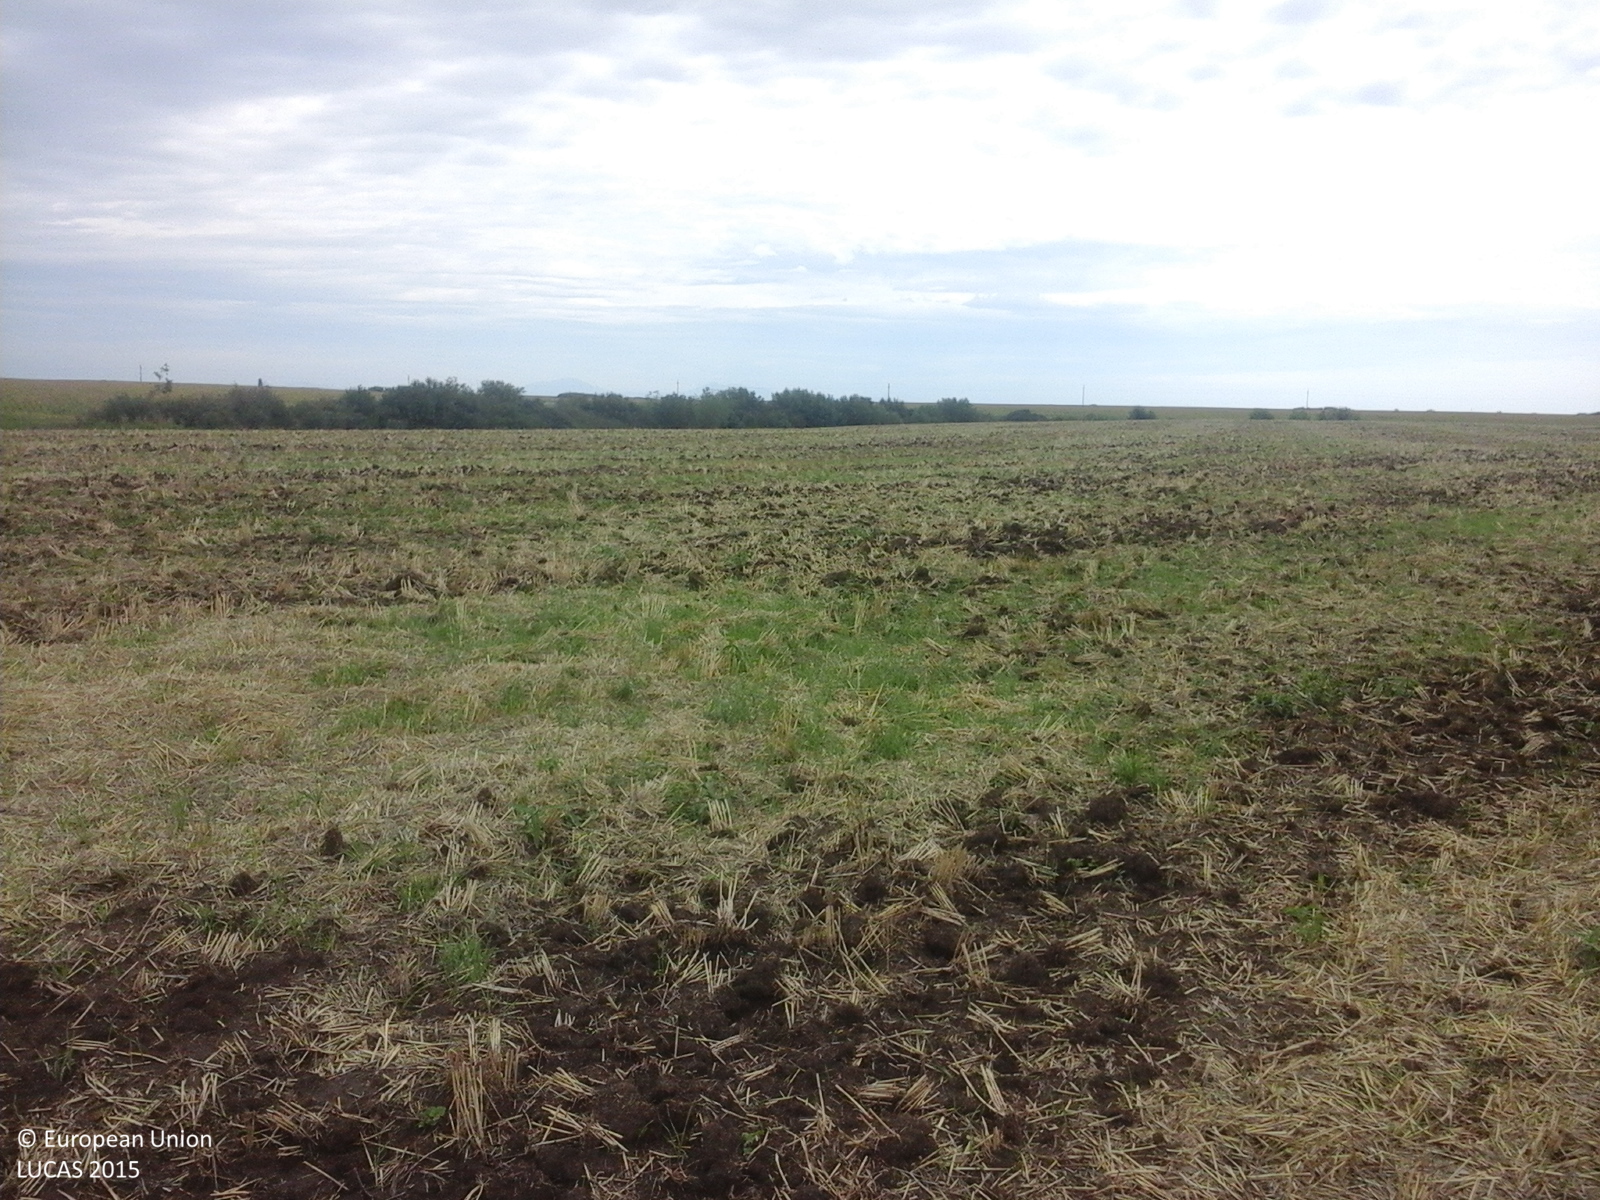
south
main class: Cropland
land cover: Common wheat
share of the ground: < 10 %
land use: Agriculture (excluding fallow land and kitchen gardens)
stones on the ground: < 10 %
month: August
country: RO
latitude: 45.4420
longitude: 21.2927
